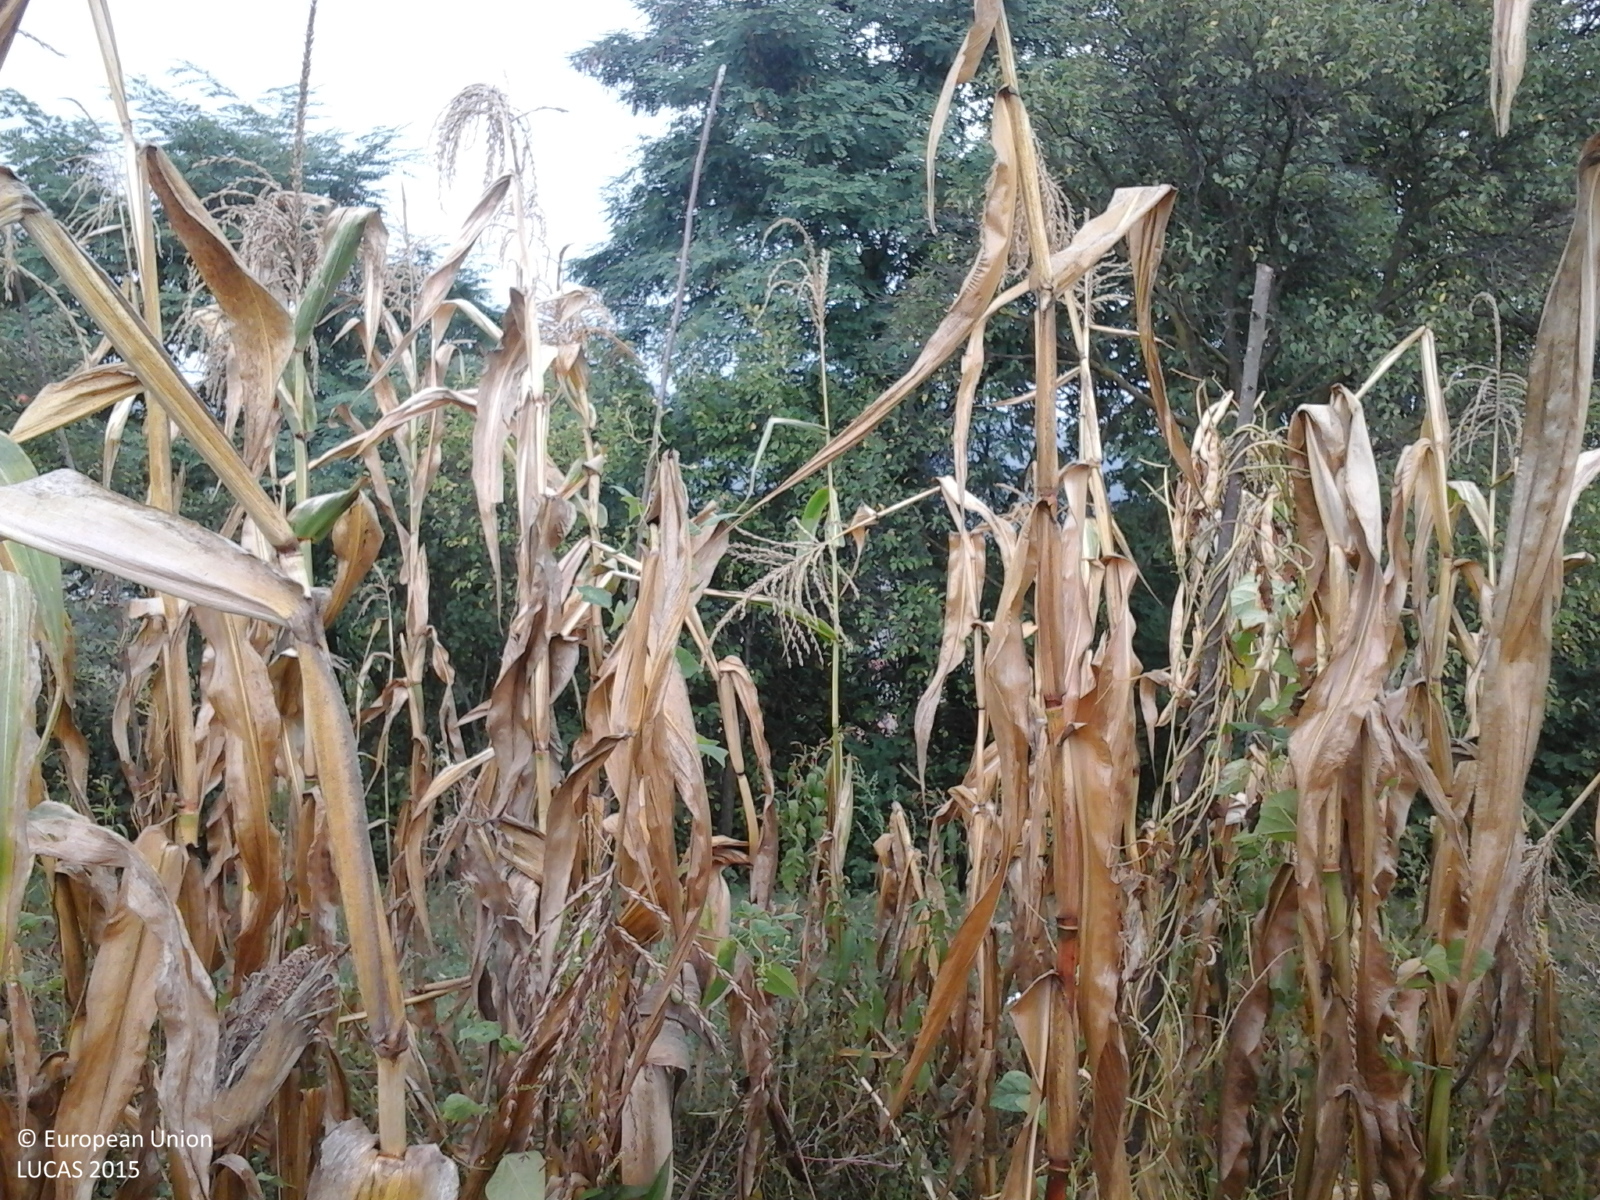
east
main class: Cropland
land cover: Maize
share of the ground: 50 - 75 %
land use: Agriculture (excluding fallow land and kitchen gardens)
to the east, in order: Maize; Other fruit trees and berries; Abandoned hedges; Fences; Broadleaved woodland; Grassland without tree/shrub cover; Single bushes/trees; Grassland without tree/shrub cover; Potatoes; Grassland without tree/shrub cover; Fences; Abandoned hedges; Grassland without tree/shrub cover; Artificial constructions in urban areas; Grassland without tree/shrub cover; Fences; Artificial constructions in urban areas
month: September
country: RO
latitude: 47.8822
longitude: 23.9243
